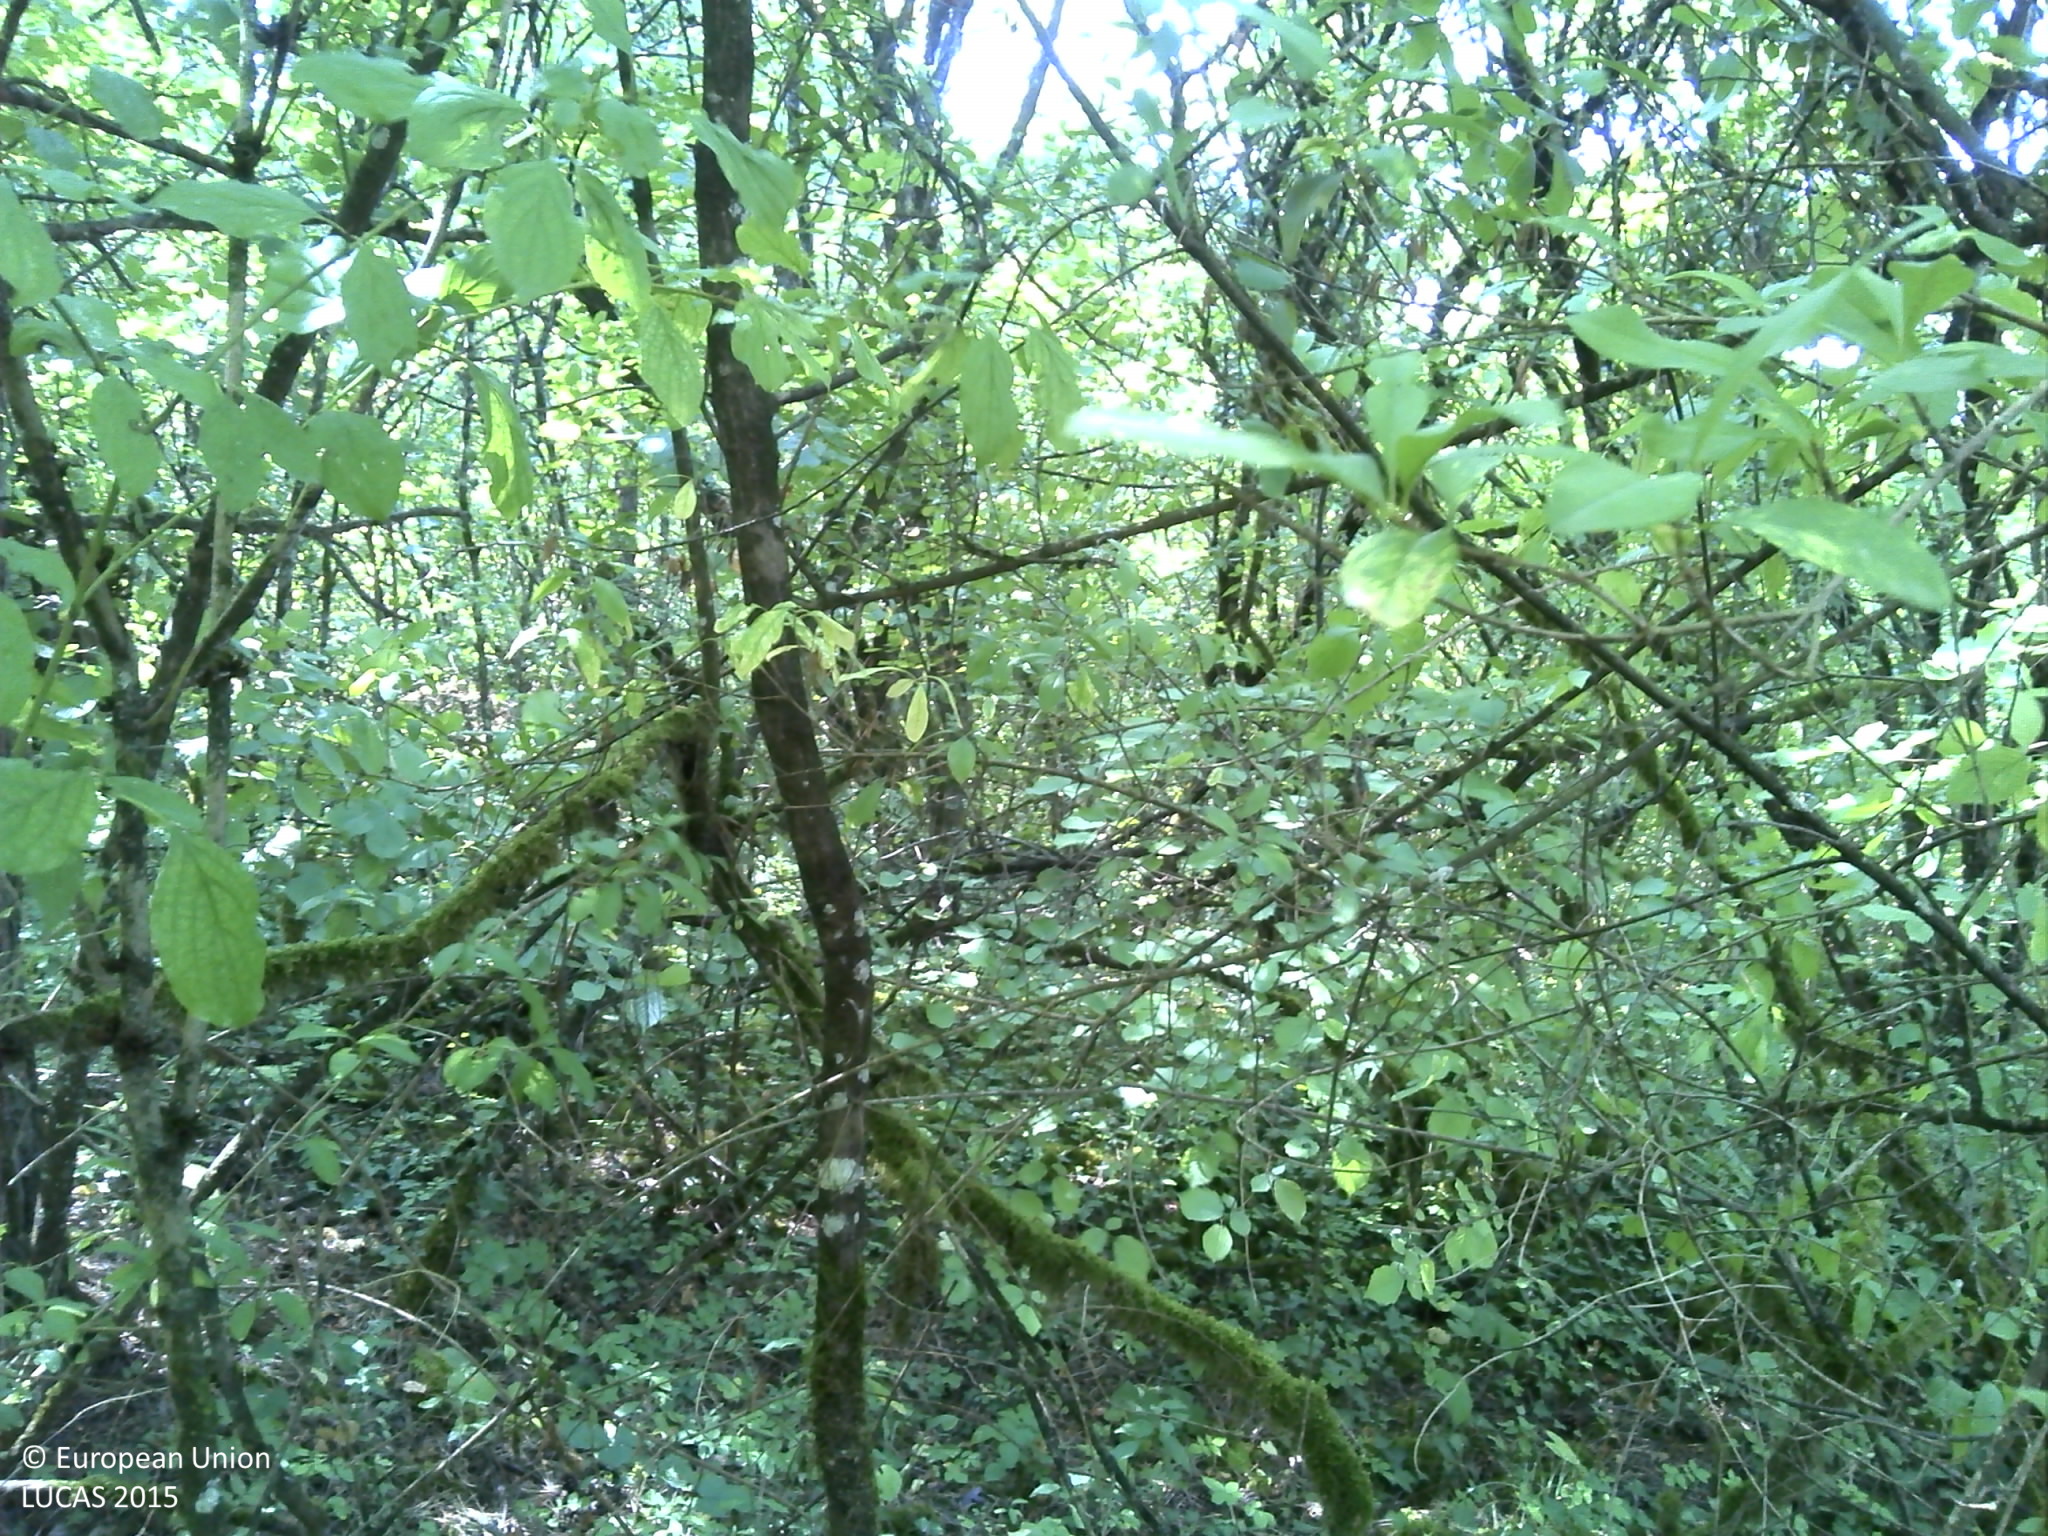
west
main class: Woodland
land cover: Broadleaved woodland
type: mesophytic deciduous forest
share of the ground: > 75 %
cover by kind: broadleaved forest trees 90 %, coniferous forest trees 5 %, herbaceous plants 5 %
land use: Semi-natural and natural areas not in use
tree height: > 5 m
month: August
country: FR
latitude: 48.9121
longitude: 4.7988
